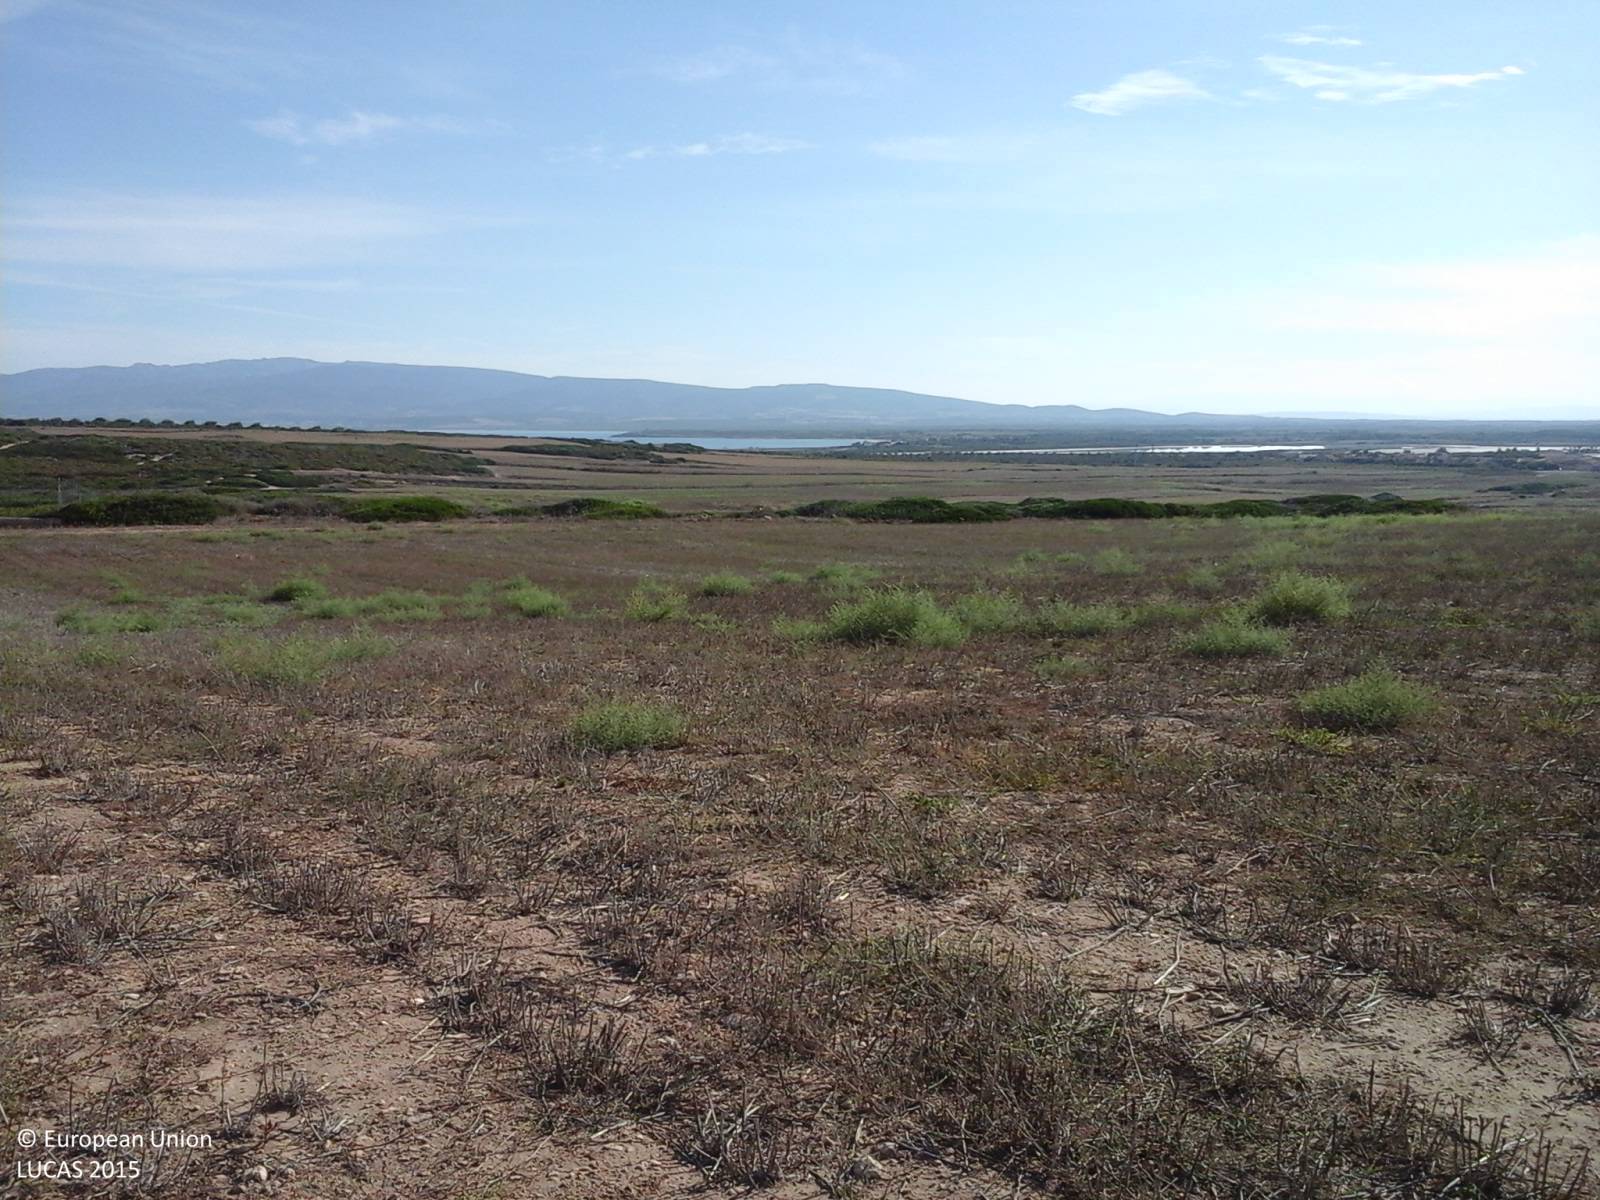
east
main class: Cropland
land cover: Mixed cereals for fodder
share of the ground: 10 - 25 %
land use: Agriculture (excluding fallow land and kitchen gardens)
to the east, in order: Mixed cereals for fodder; Shrubland without tree cover; Barley; Shrubland without tree cover; Barley; Shrubland without tree cover; Barley; Grass margins; Barley
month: September
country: IT
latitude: 40.0367
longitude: 8.3797
